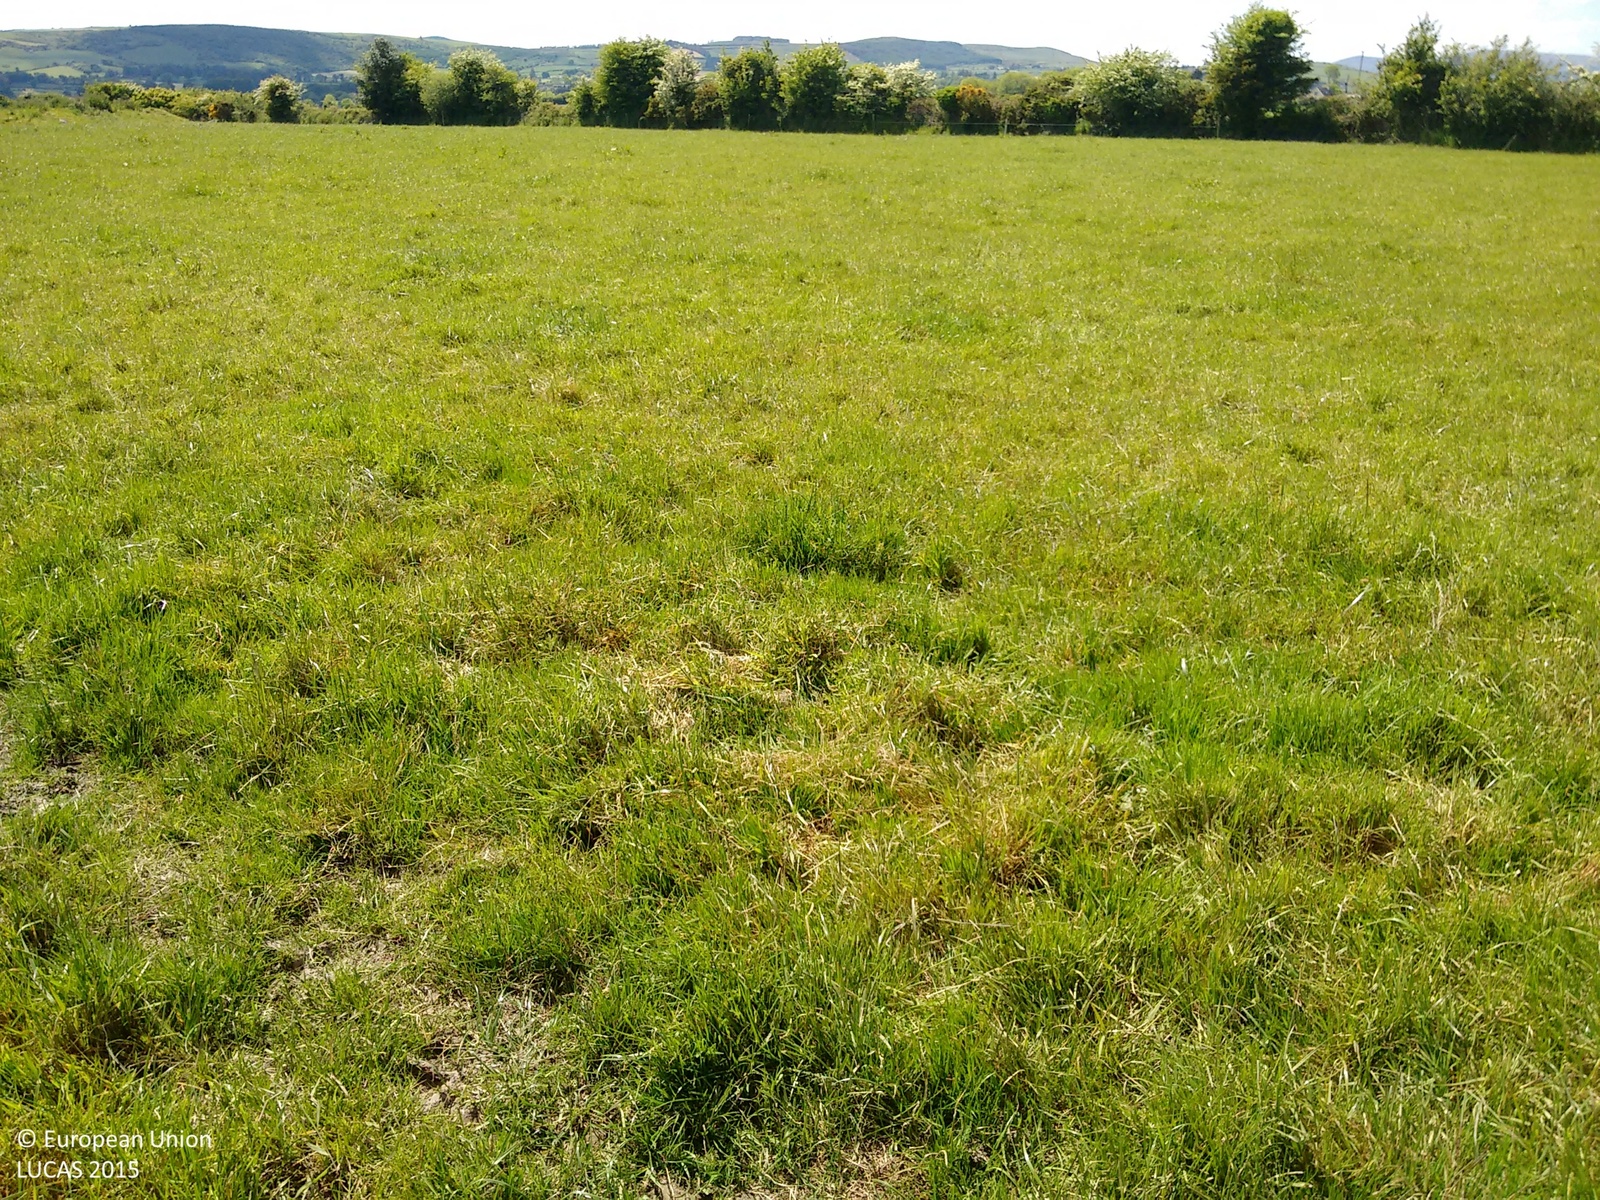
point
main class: Grassland
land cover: Grassland without tree/shrub cover
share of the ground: > 75 %
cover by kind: herbaceous plants 95 %, shrubs 5 %
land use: Agriculture (excluding fallow land and kitchen gardens)
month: June
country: IE
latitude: 51.9785
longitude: -8.8270
